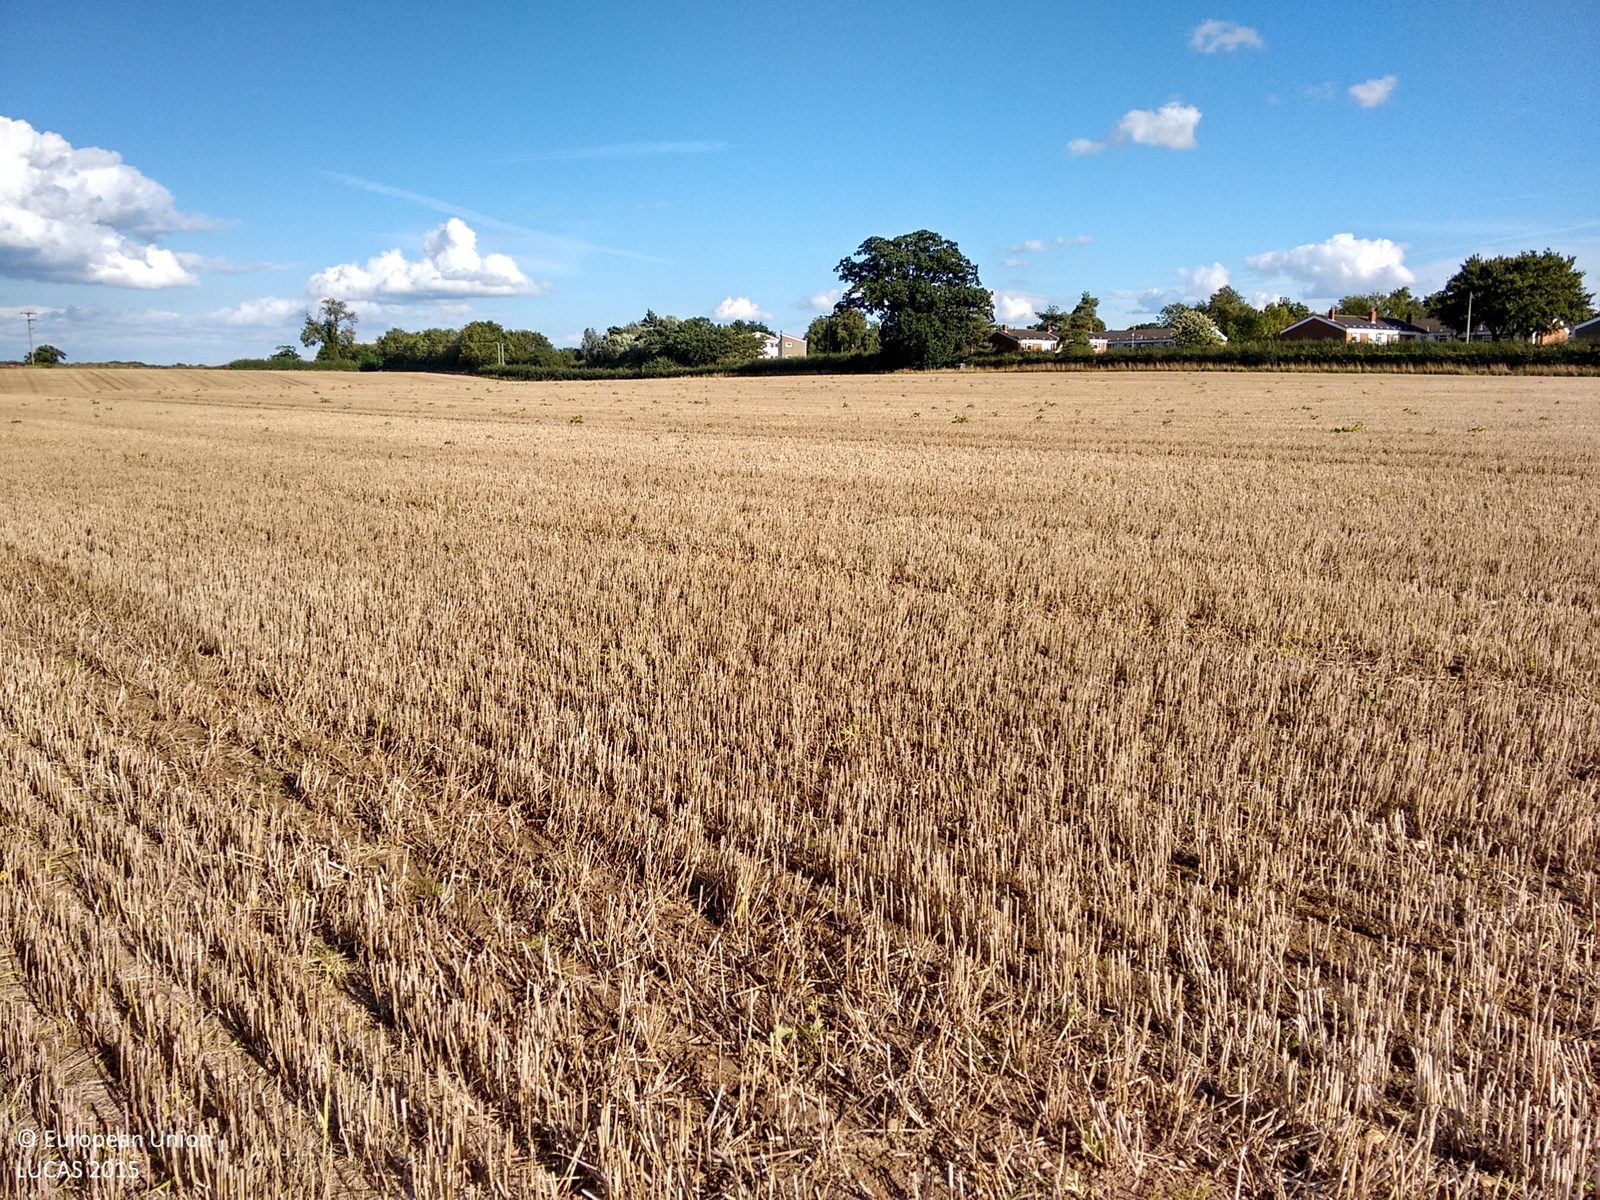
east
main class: Cropland
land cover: Common wheat
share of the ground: > 75 %
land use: Agriculture (excluding fallow land and kitchen gardens)
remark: Harvested field
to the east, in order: Common wheat; Grass margins; Managed hedges; Electric lines; Grass margins; Paved roads, cycling and walking lanes; Grass margins; Ditches and canals; Grass margins; Artificial constructions in urban areas
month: September
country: GB
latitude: 52.7658
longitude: 1.3396
